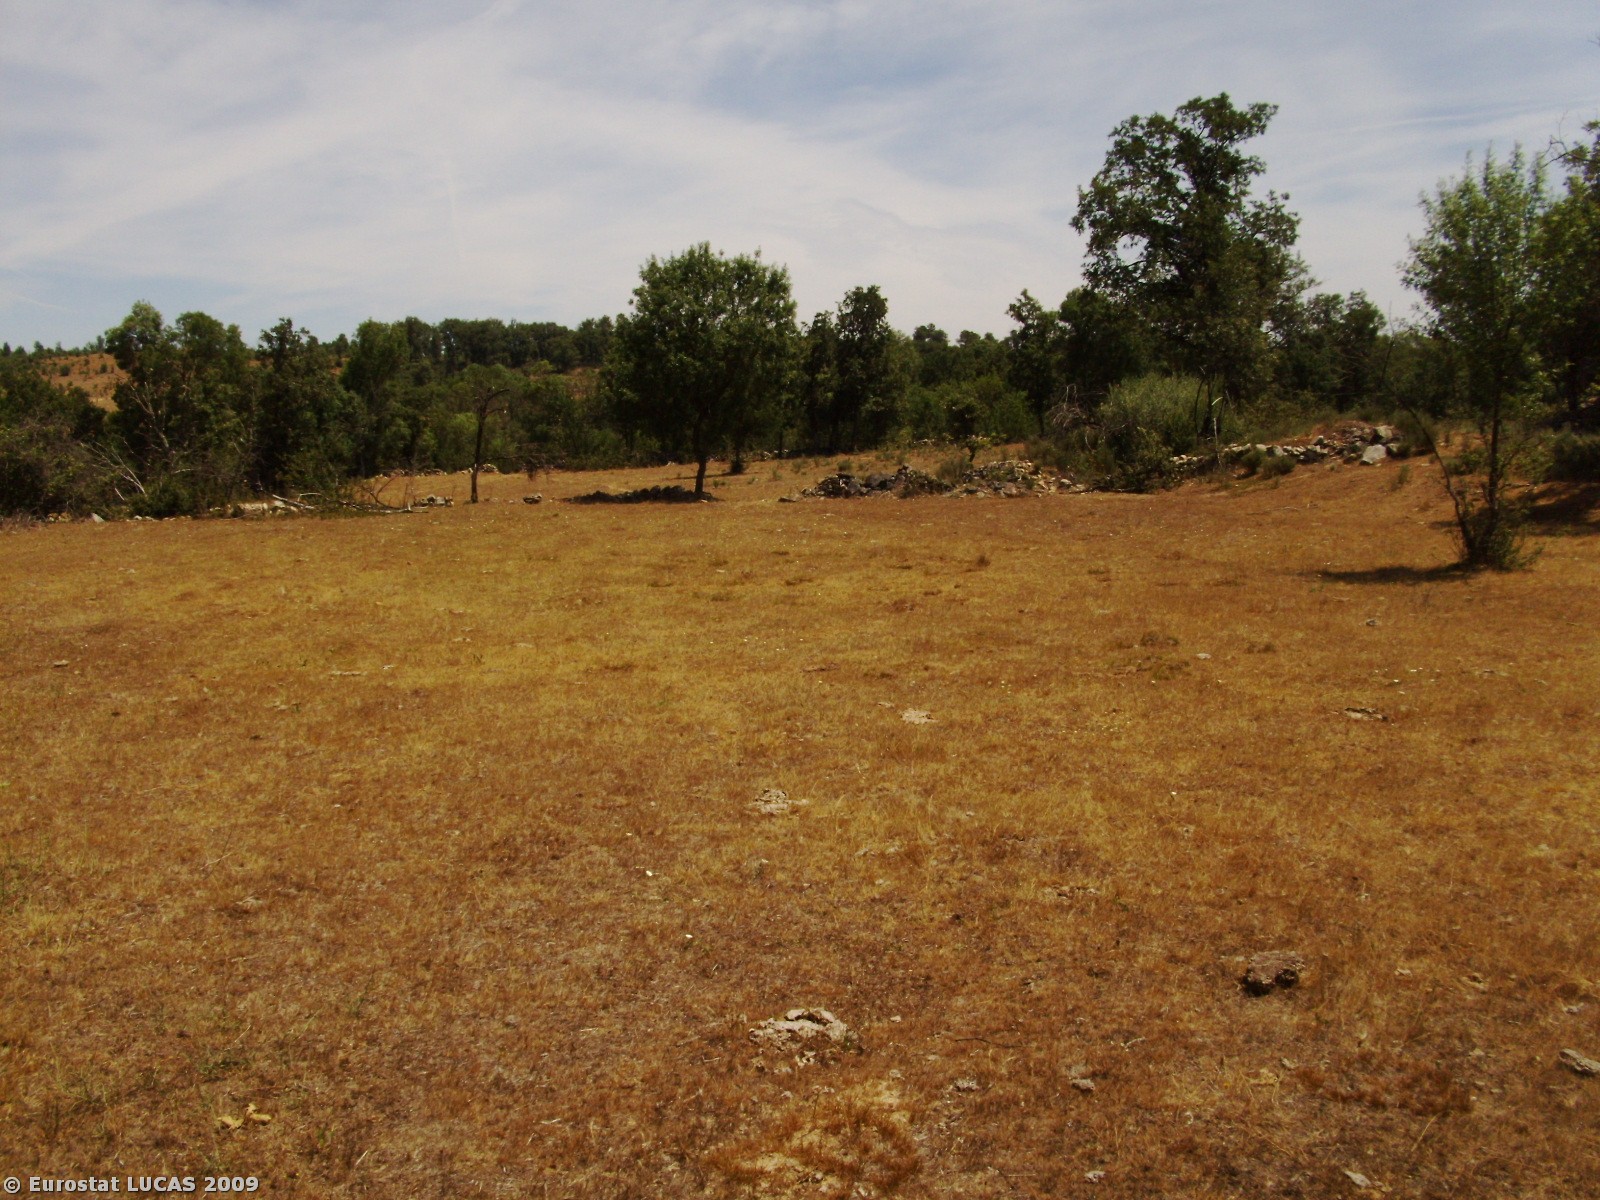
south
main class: Grassland
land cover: Spontaneously vegetated surfaces
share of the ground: > 75 %
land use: Fallow land
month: July
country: PT
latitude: 40.4149
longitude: -6.9848
